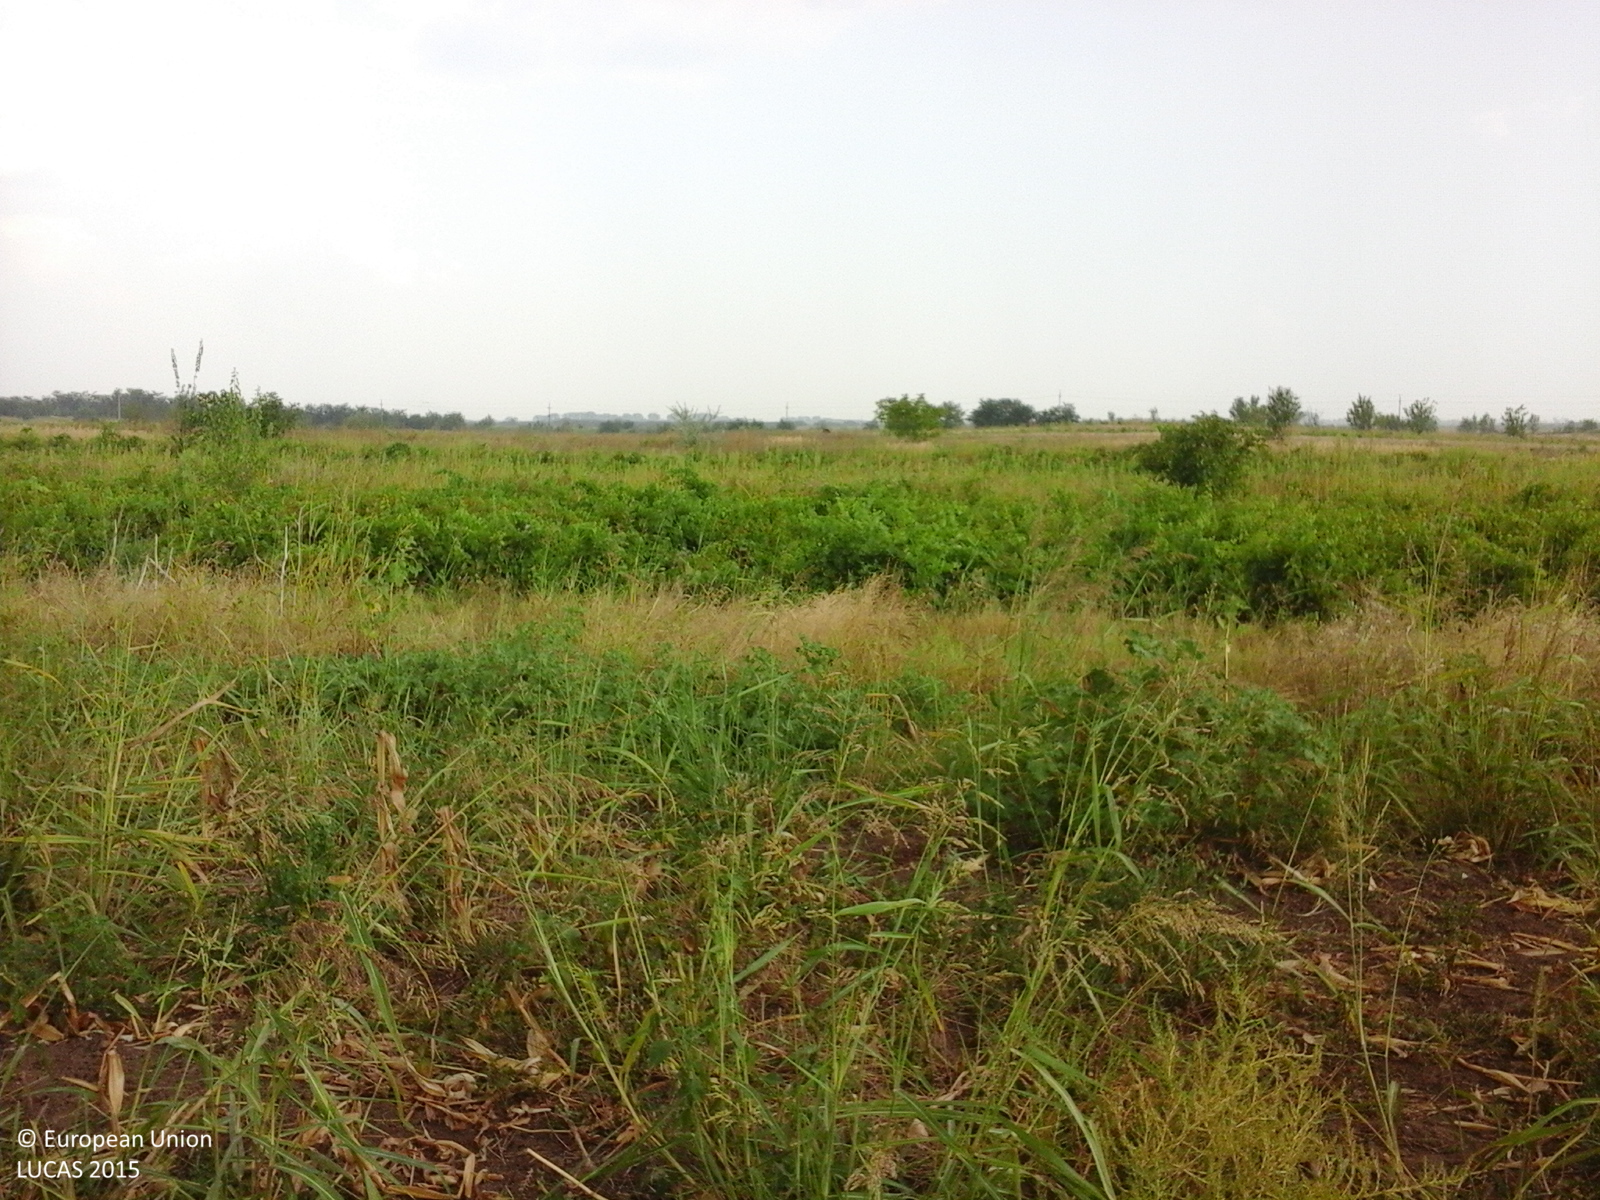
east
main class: Grassland
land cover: Spontaneously vegetated surfaces
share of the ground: 50 - 75 %
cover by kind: herbaceous plants 75 %, consolidated bare surface 25 %
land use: Agriculture (excluding fallow land and kitchen gardens)
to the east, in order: Spontaneously vegetated surfaces; Grass margins; Tracks; Vineyards; Common wheat; Vineyards; Spontaneously vegetated surfaces; Vineyards; Spontaneously vegetated surfaces; Common wheat; Spontaneously vegetated surfaces; Vineyards; Spontaneously vegetated surfaces; Grass margins; Tracks; Grass margins; Lucerne; Grassland without tree/shrub cover
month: August
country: RO
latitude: 43.9054
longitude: 23.0528
